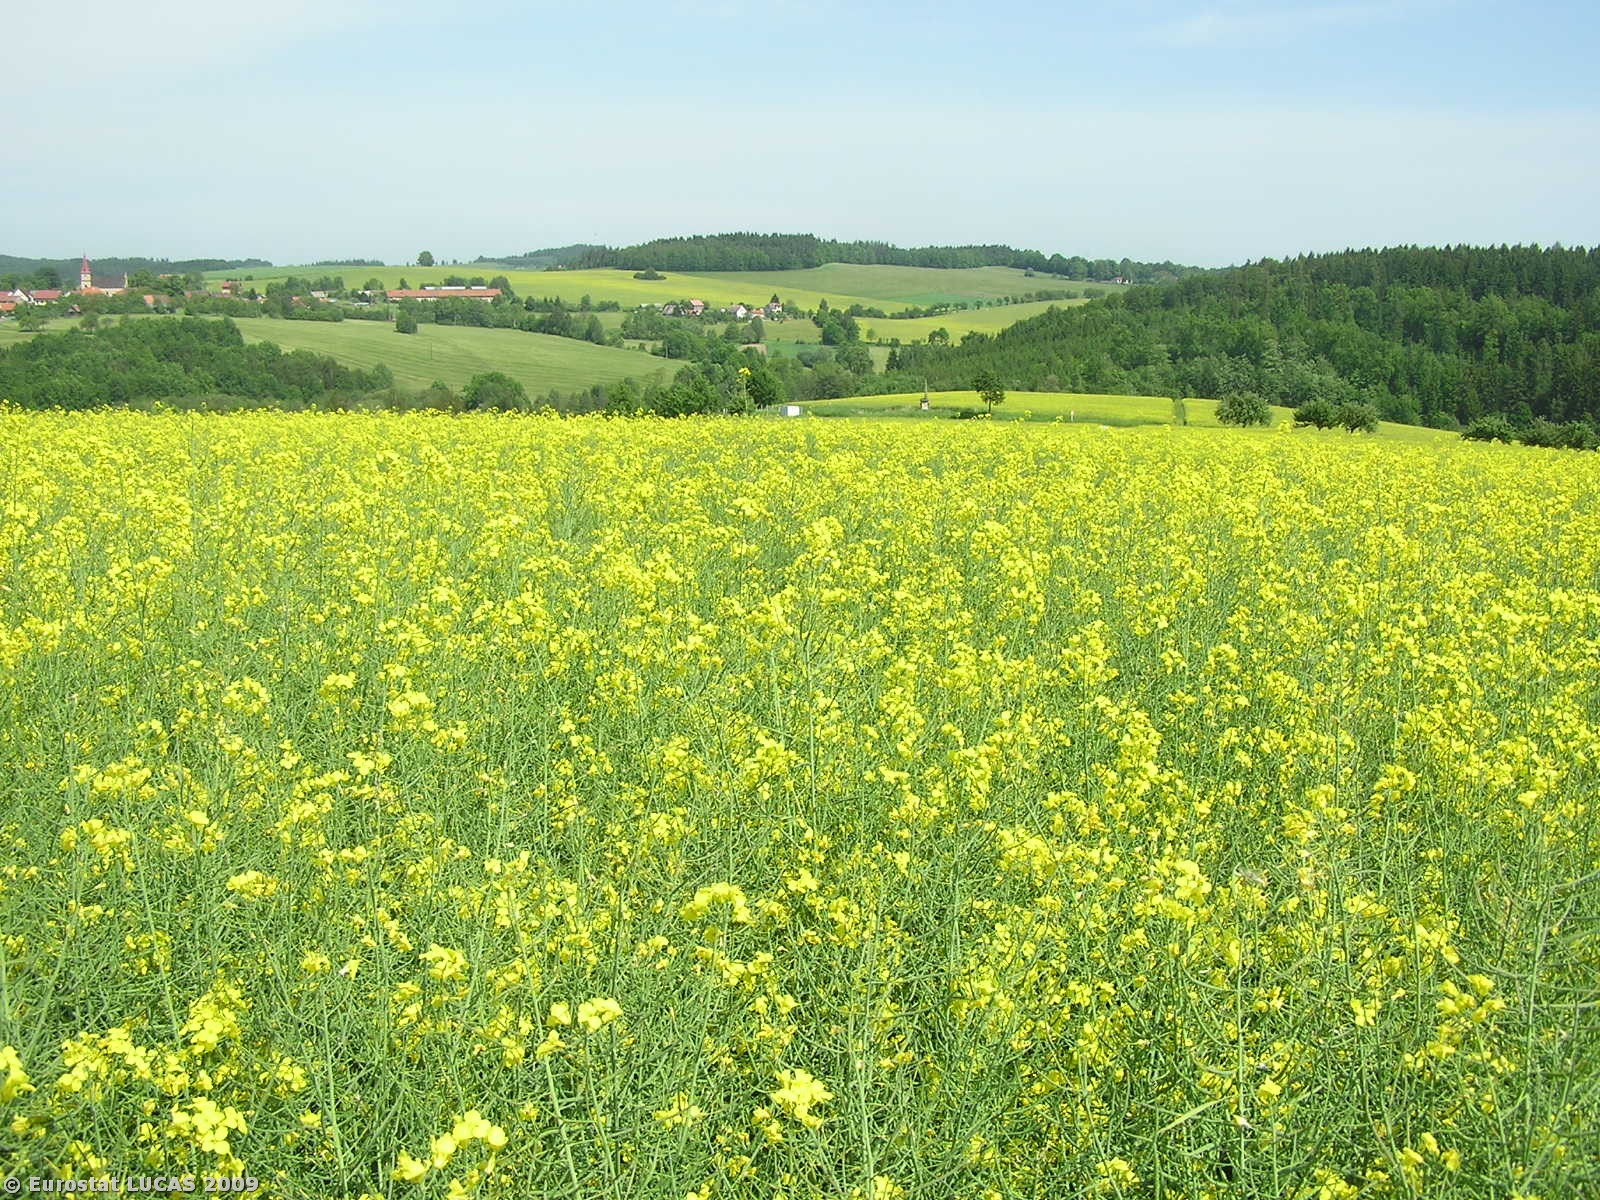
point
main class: Cropland
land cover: Rape and turnip rape
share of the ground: > 75 %
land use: Agriculture (excluding fallow land and kitchen gardens)
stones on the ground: 10 - 25 %
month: May
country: CZ
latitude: 49.6047
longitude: 14.6096
